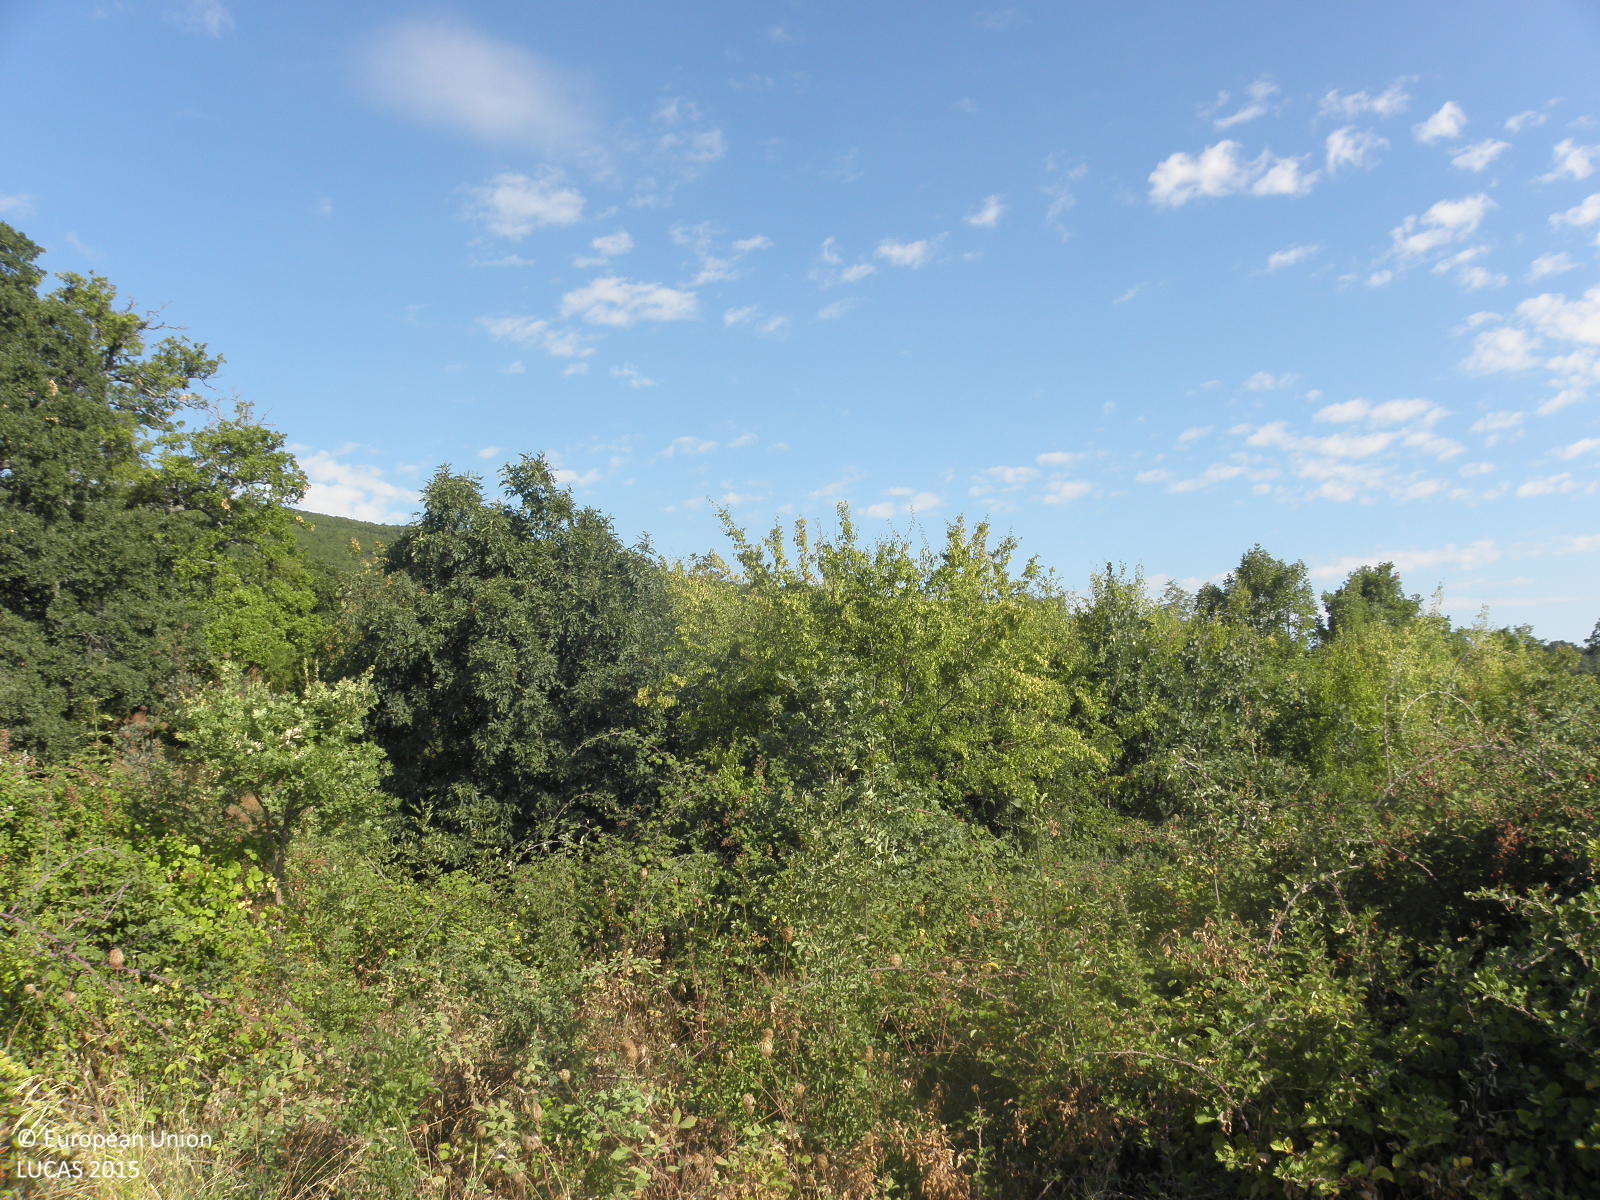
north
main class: Woodland
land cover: Broadleaved woodland
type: thermophilous deciduous forest
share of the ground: > 75 %
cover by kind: broadleaved forest trees 100 %
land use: Semi-natural and natural areas not in use
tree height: > 5 m
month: August
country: GR
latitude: 39.9452
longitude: 22.6004
